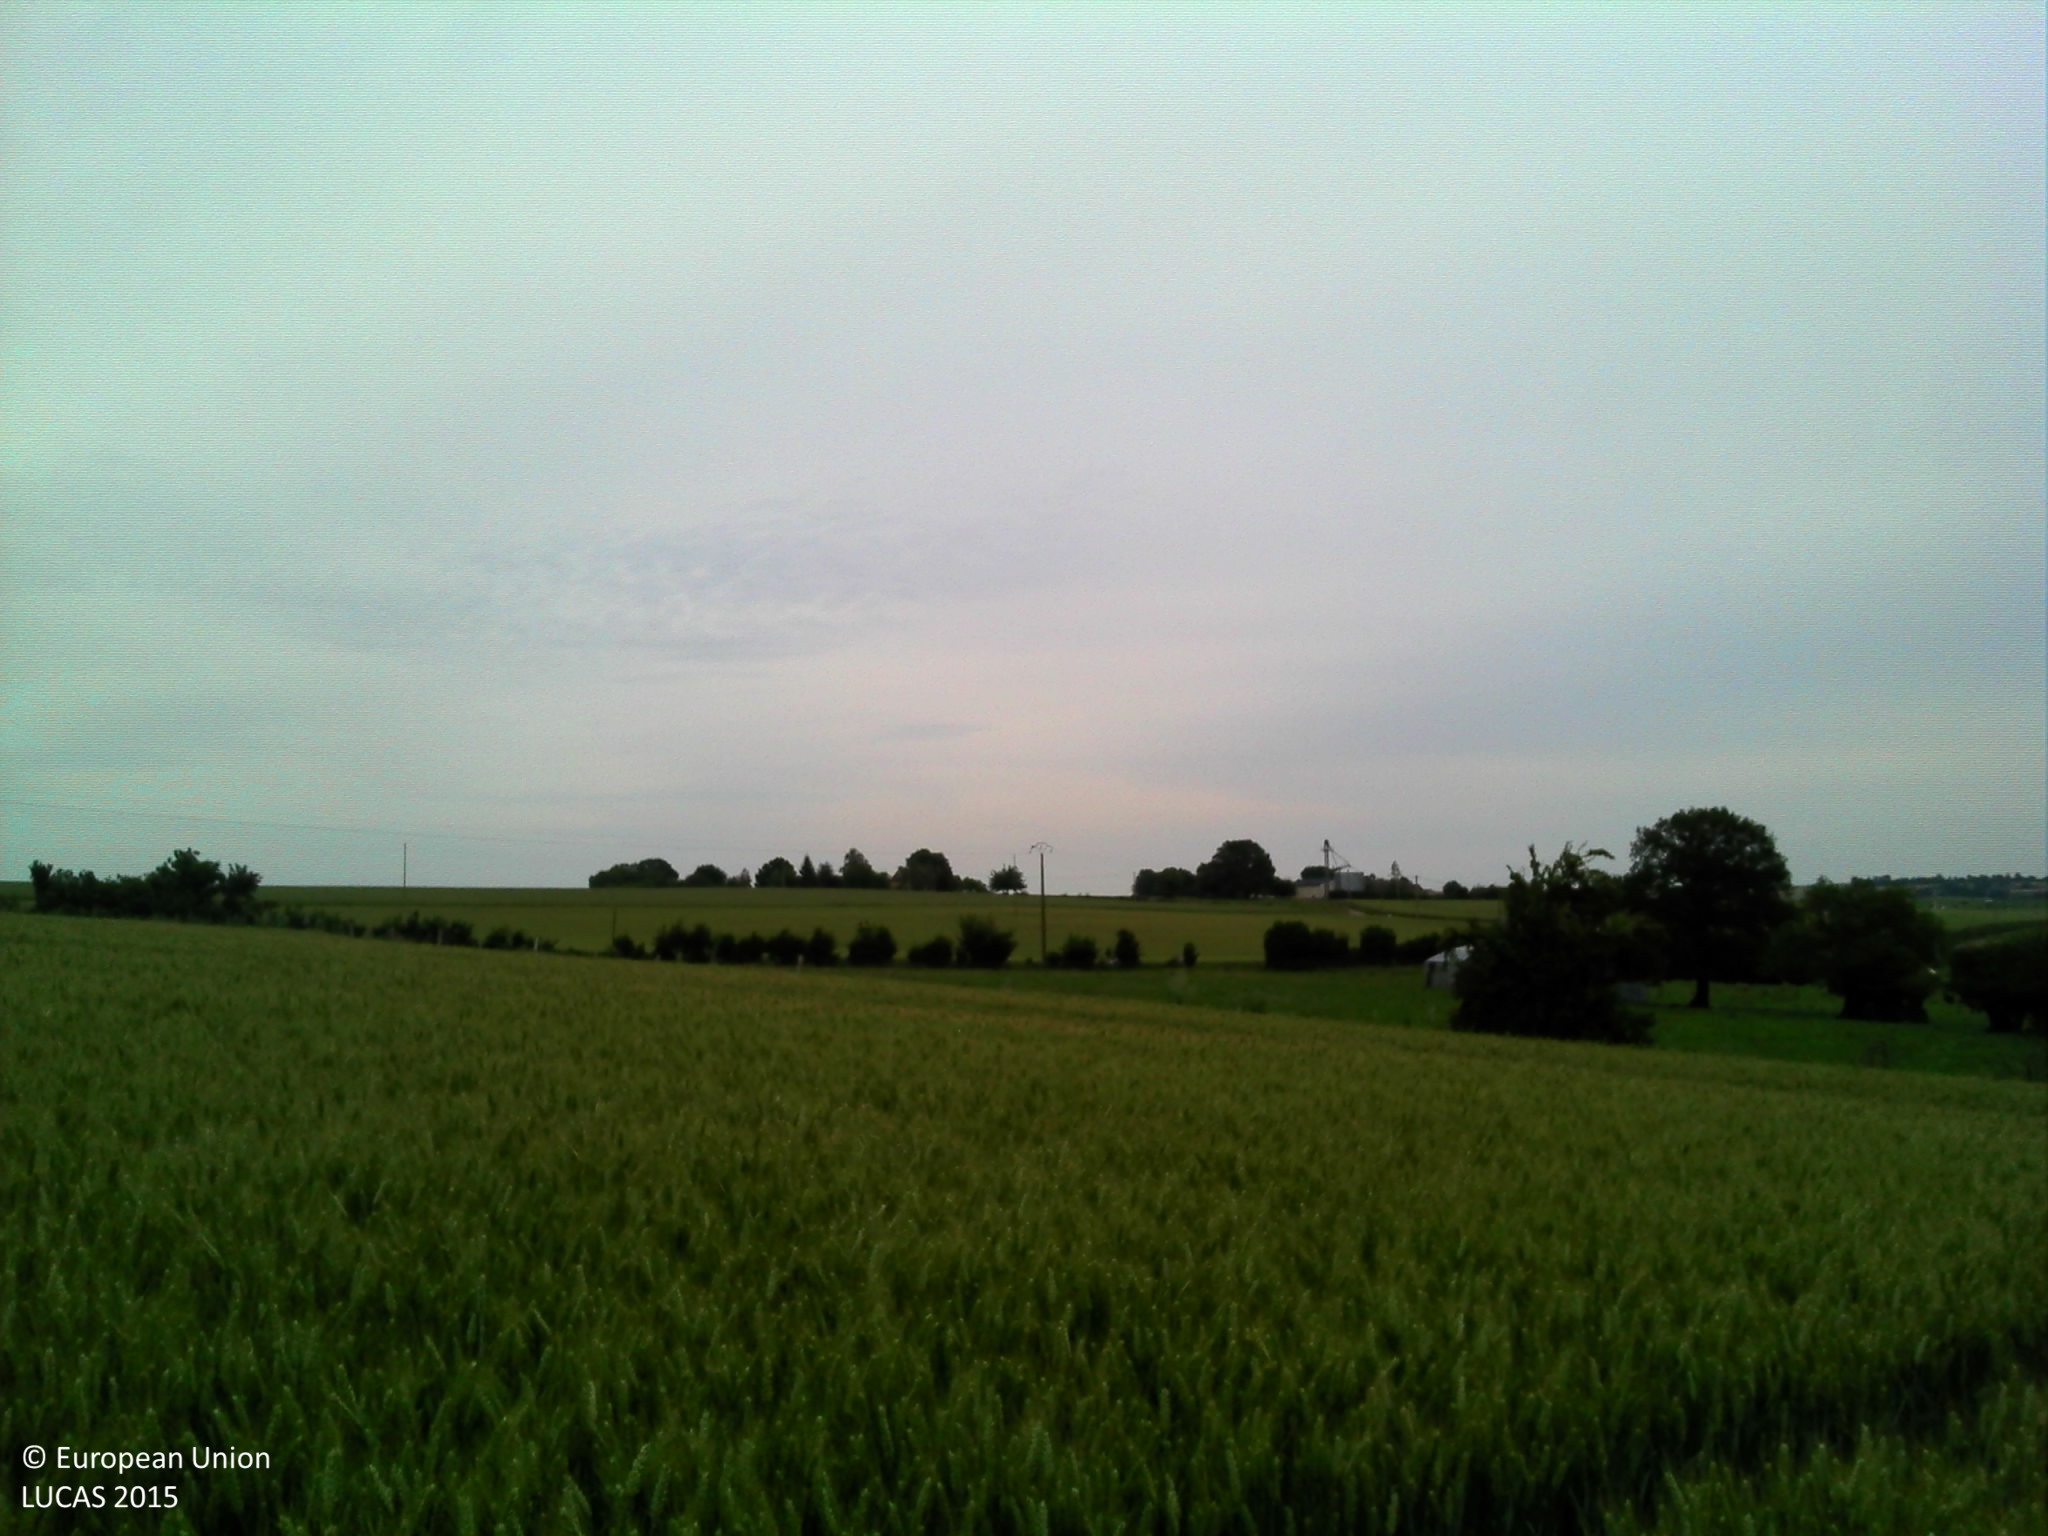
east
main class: Cropland
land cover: Triticale
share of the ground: > 75 %
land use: Agriculture (excluding fallow land and kitchen gardens)
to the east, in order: Triticale; Fences; Grassland without tree/shrub cover; Artificial constructions in urban areas; Grassland without tree/shrub cover; Fences; Managed hedges; Ditches and canals; Grass margins; Paved roads, cycling and walking lanes
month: June
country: FR
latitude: 48.2871
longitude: -0.0703
